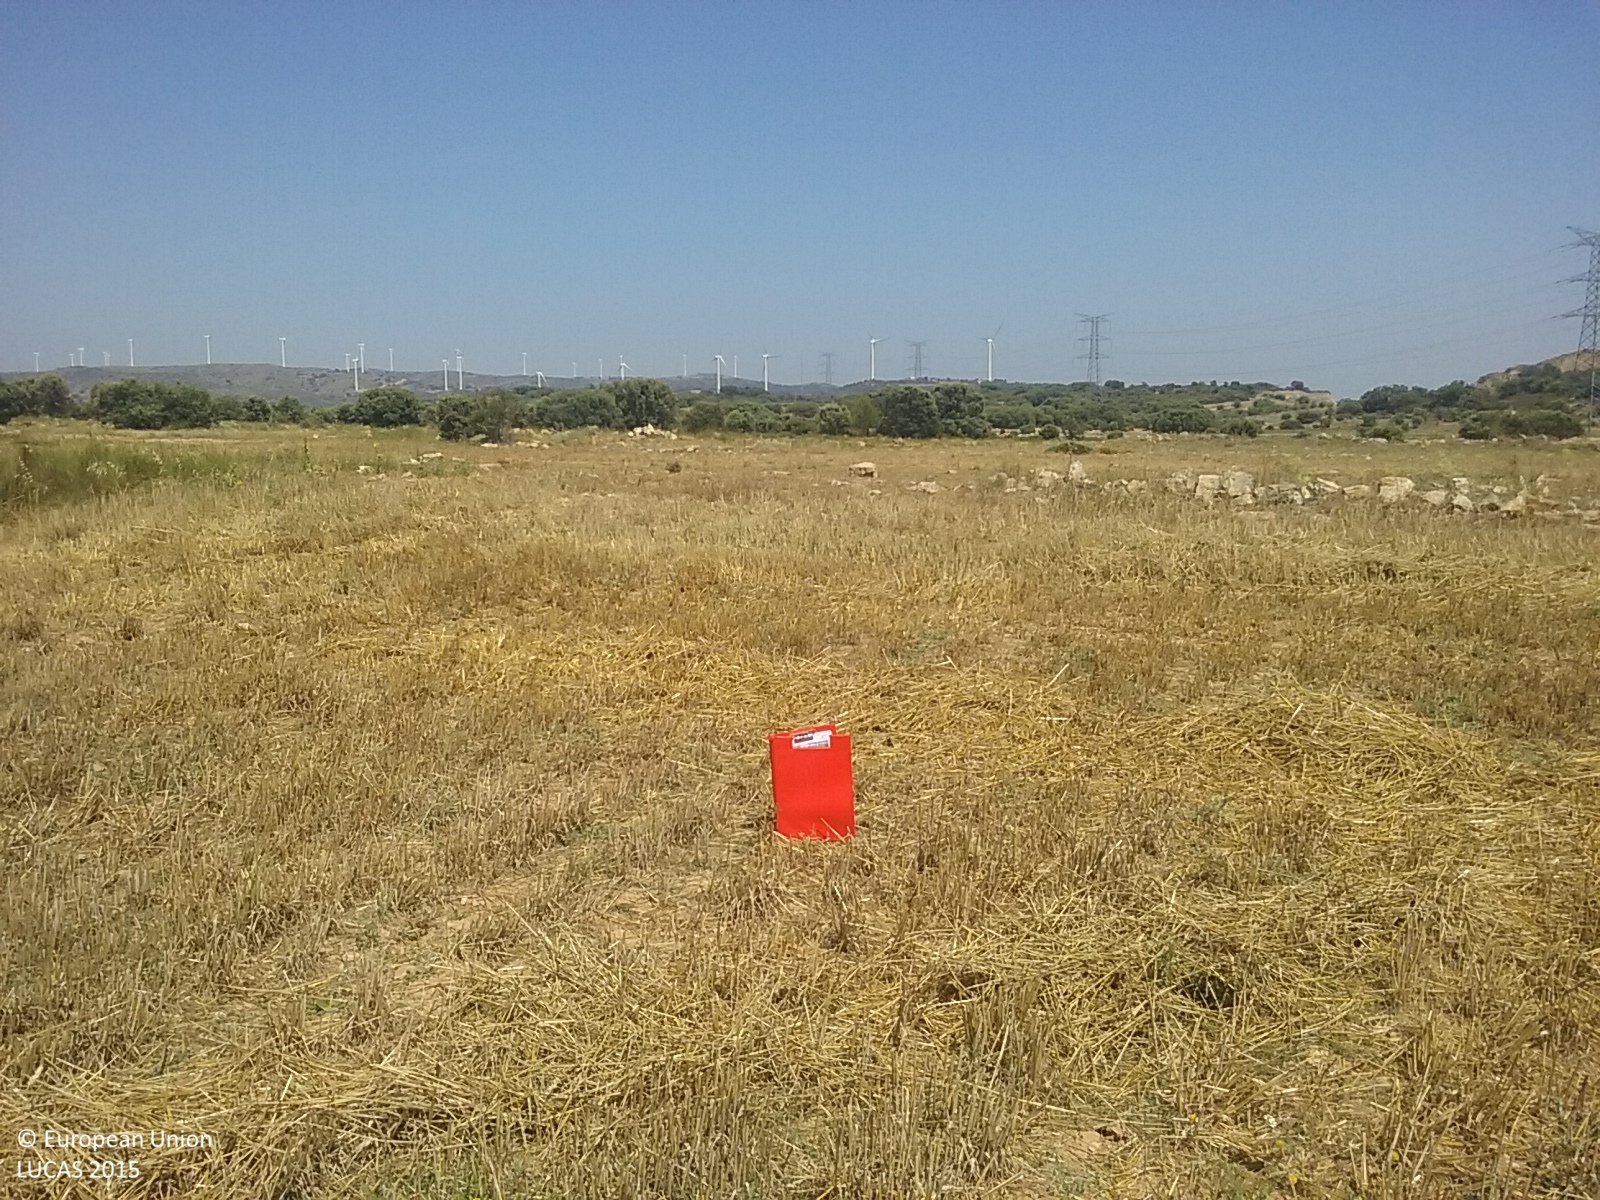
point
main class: Cropland
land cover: Barley
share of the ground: < 10 %
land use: Agriculture (excluding fallow land and kitchen gardens)
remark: Harvested field
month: July
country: ES
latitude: 39.9933
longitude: -0.6740
